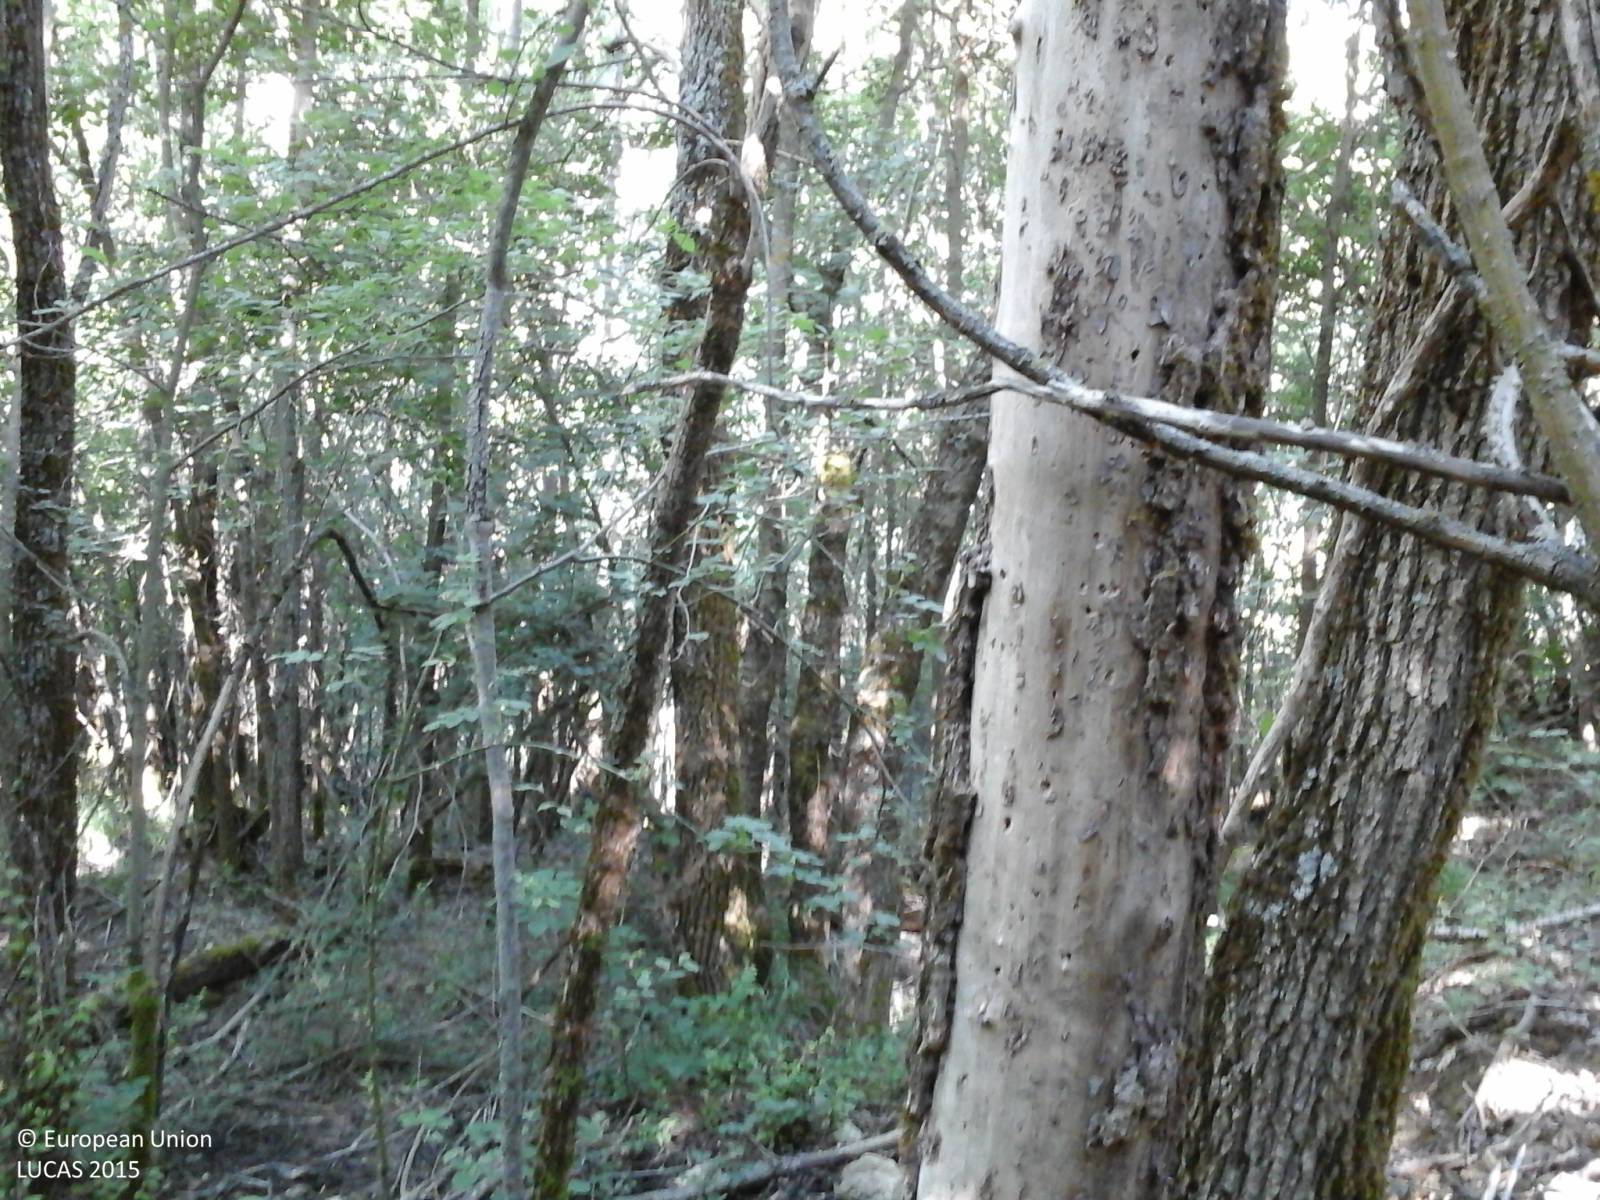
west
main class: Woodland
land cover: Broadleaved woodland
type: thermophilous deciduous forest
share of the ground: > 75 %
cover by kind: broadleaved forest trees 100 %
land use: Forestry
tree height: > 5 m
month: June
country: IT
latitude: 41.9855
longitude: 13.8133
